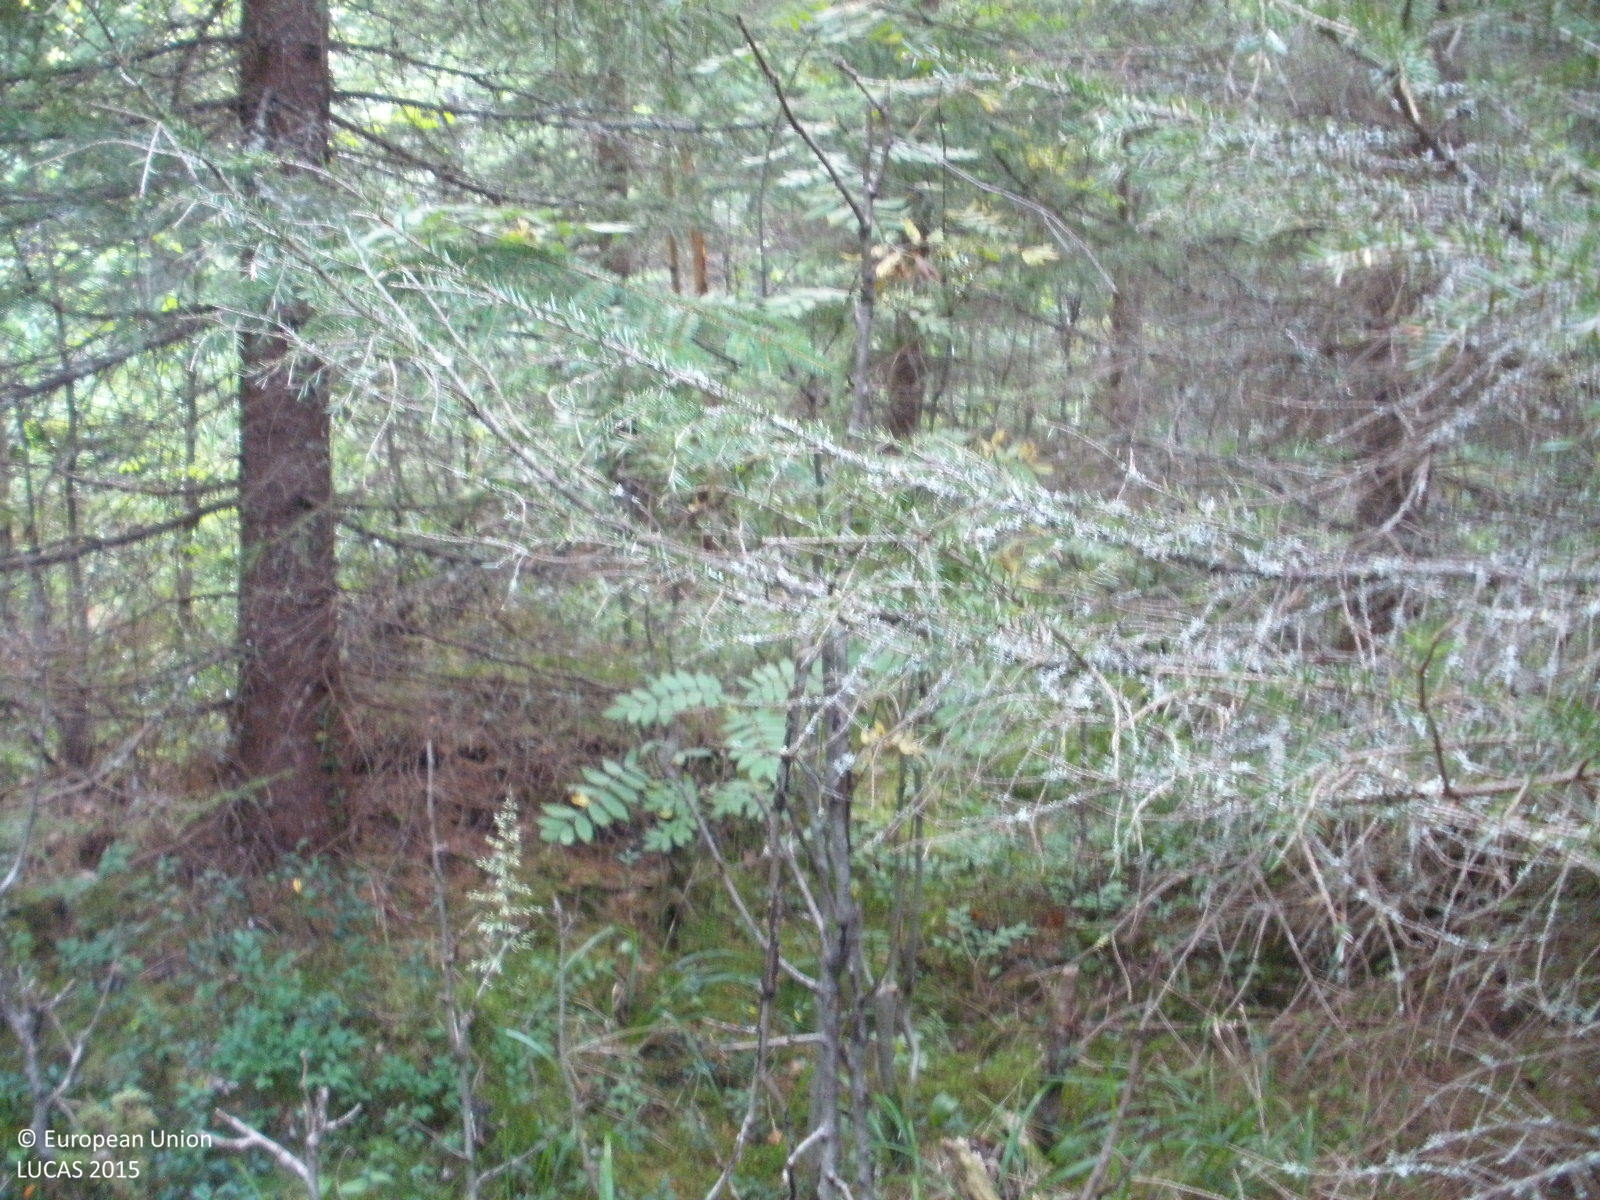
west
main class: Woodland
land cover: Spruce dominated coniferous woodland
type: boreal forest
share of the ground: > 75 %
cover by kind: coniferous forest trees 80 %, lichens and mosses 10 %, broadleaved forest trees 5 %, herbaceous plants 5 %
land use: Forestry
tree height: > 5 m
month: August
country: FI
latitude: 61.0090
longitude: 24.8137
